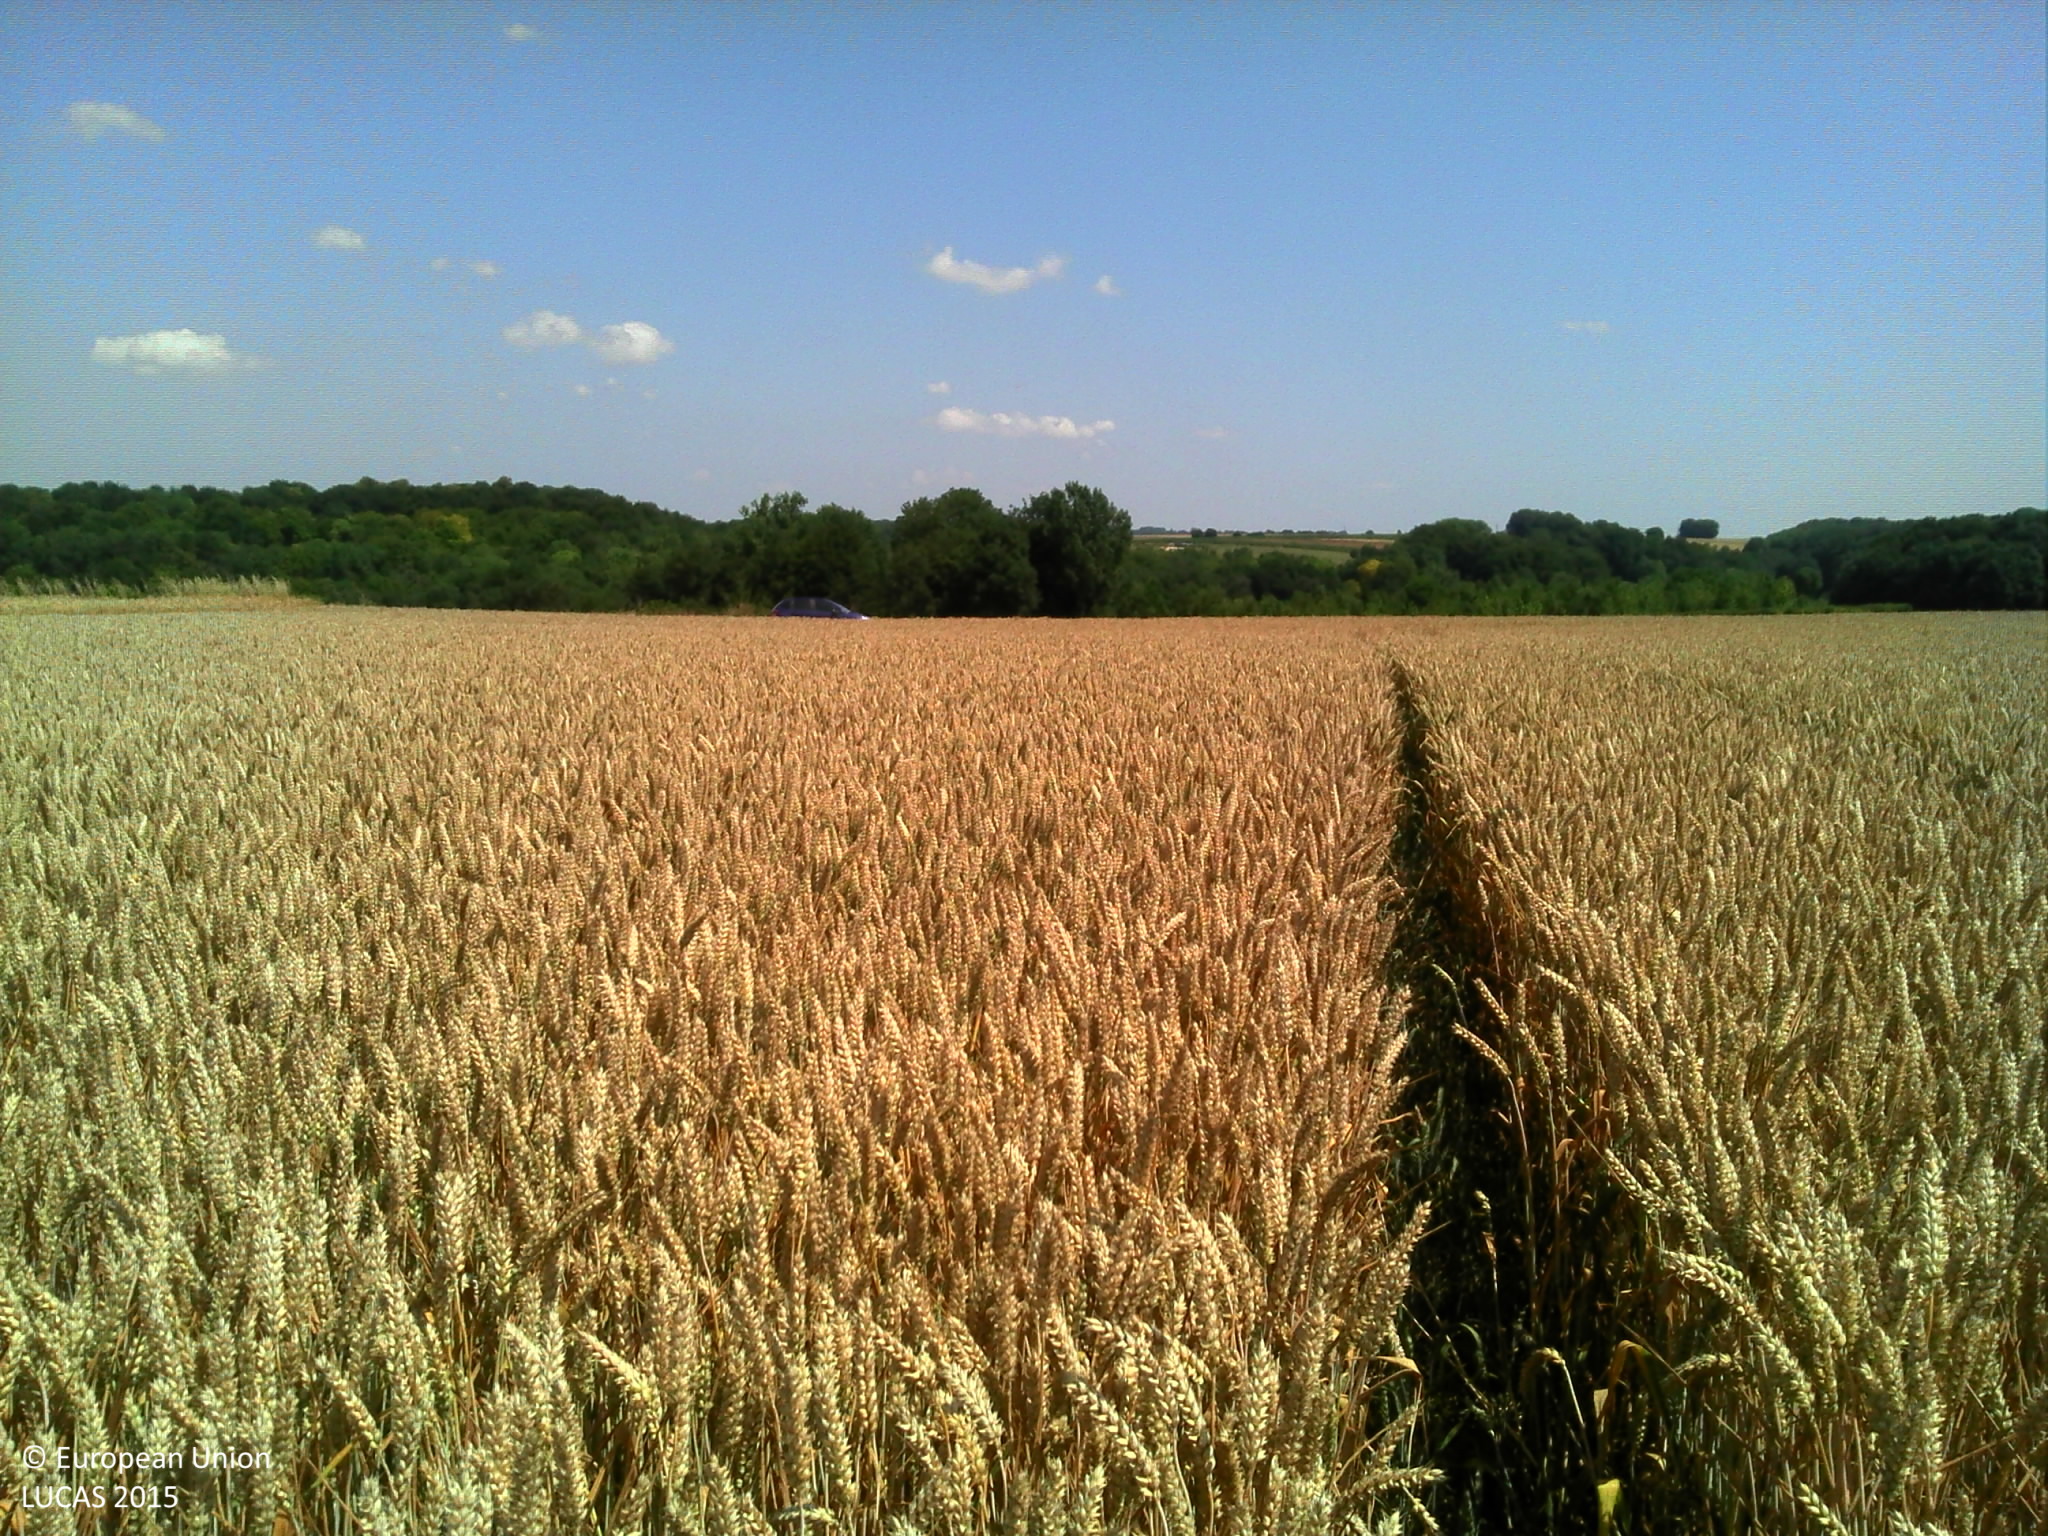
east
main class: Cropland
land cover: Common wheat
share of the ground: > 75 %
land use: Agriculture (excluding fallow land and kitchen gardens)
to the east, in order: Common wheat; Grass margins; Paved roads, cycling and walking lanes; Grass margins; Common wheat; Managed hedges; Fences; Broadleaved woodland
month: July
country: FR
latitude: 50.0279
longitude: 2.2387
